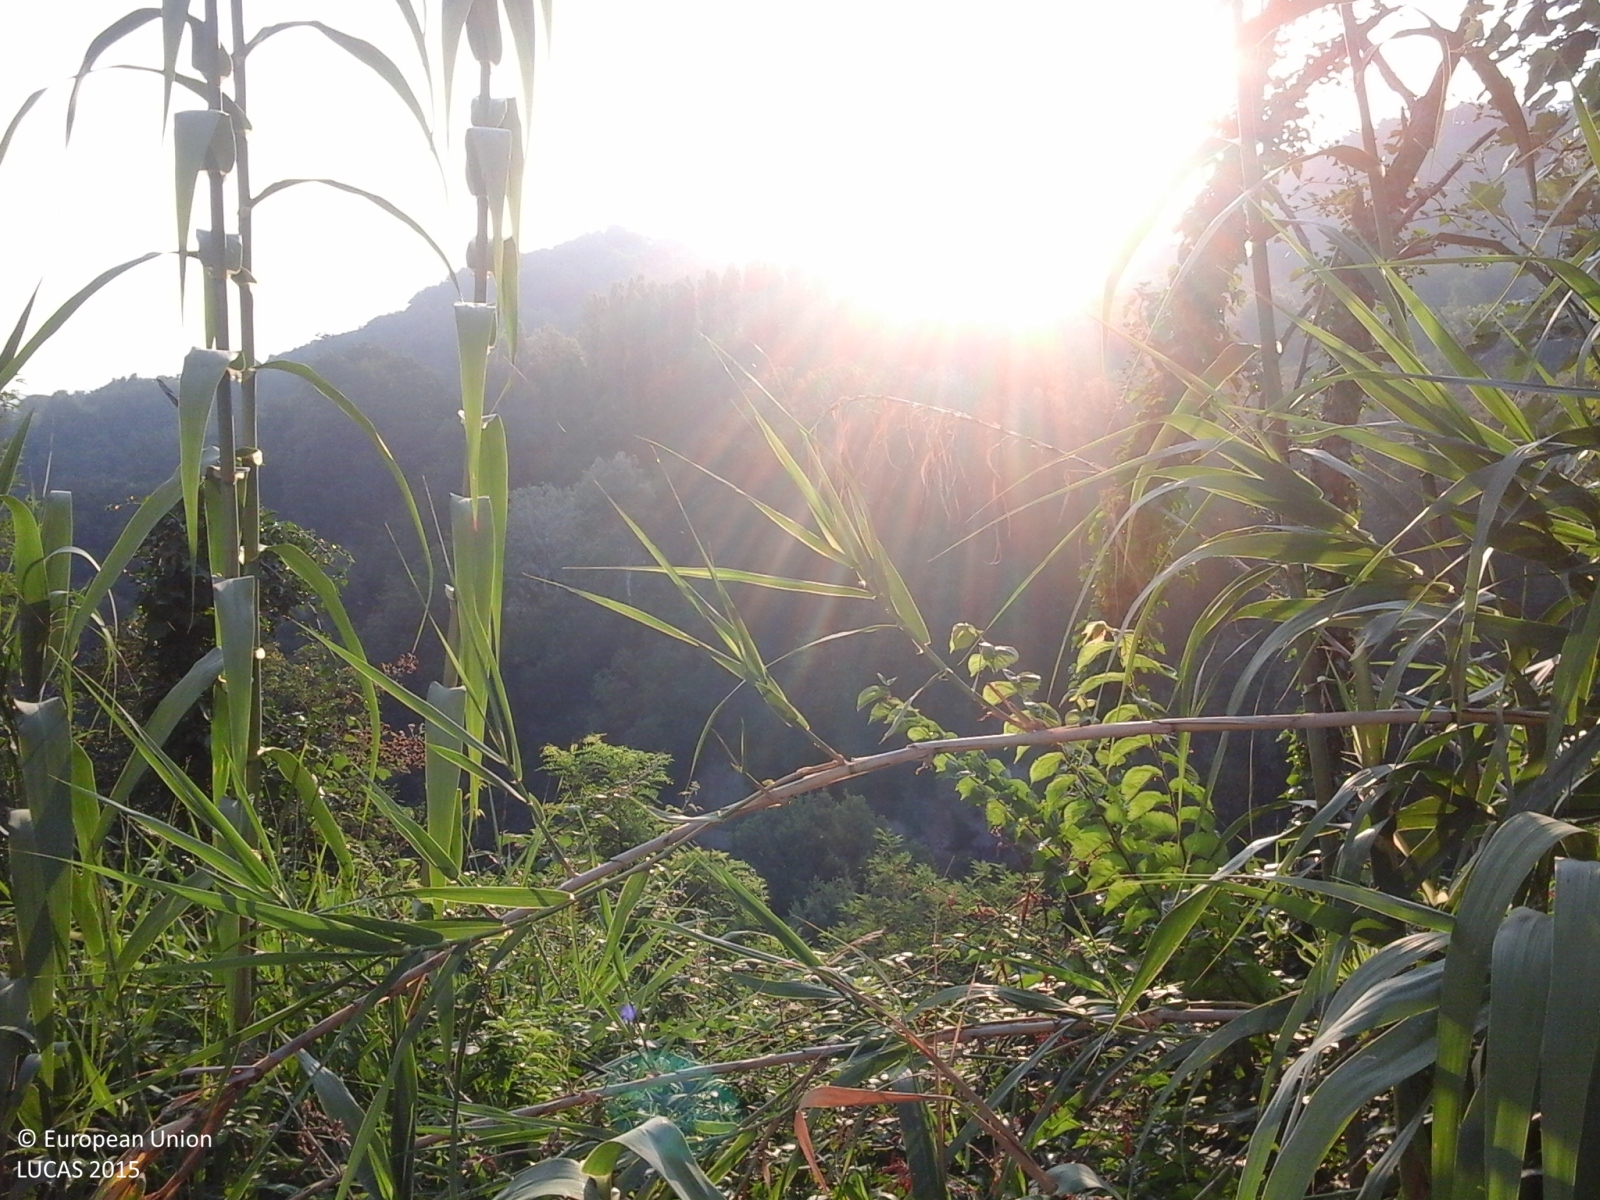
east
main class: Woodland
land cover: Broadleaved woodland
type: thermophilous deciduous forest
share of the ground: > 75 %
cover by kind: broadleaved forest trees 100 %
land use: Semi-natural and natural areas not in use
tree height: > 5 m
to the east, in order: Broadleaved woodland; Ditches and canals; Broadleaved woodland; Cherry fruit; Broadleaved woodland
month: July
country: IT
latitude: 44.0740
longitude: 12.2299
